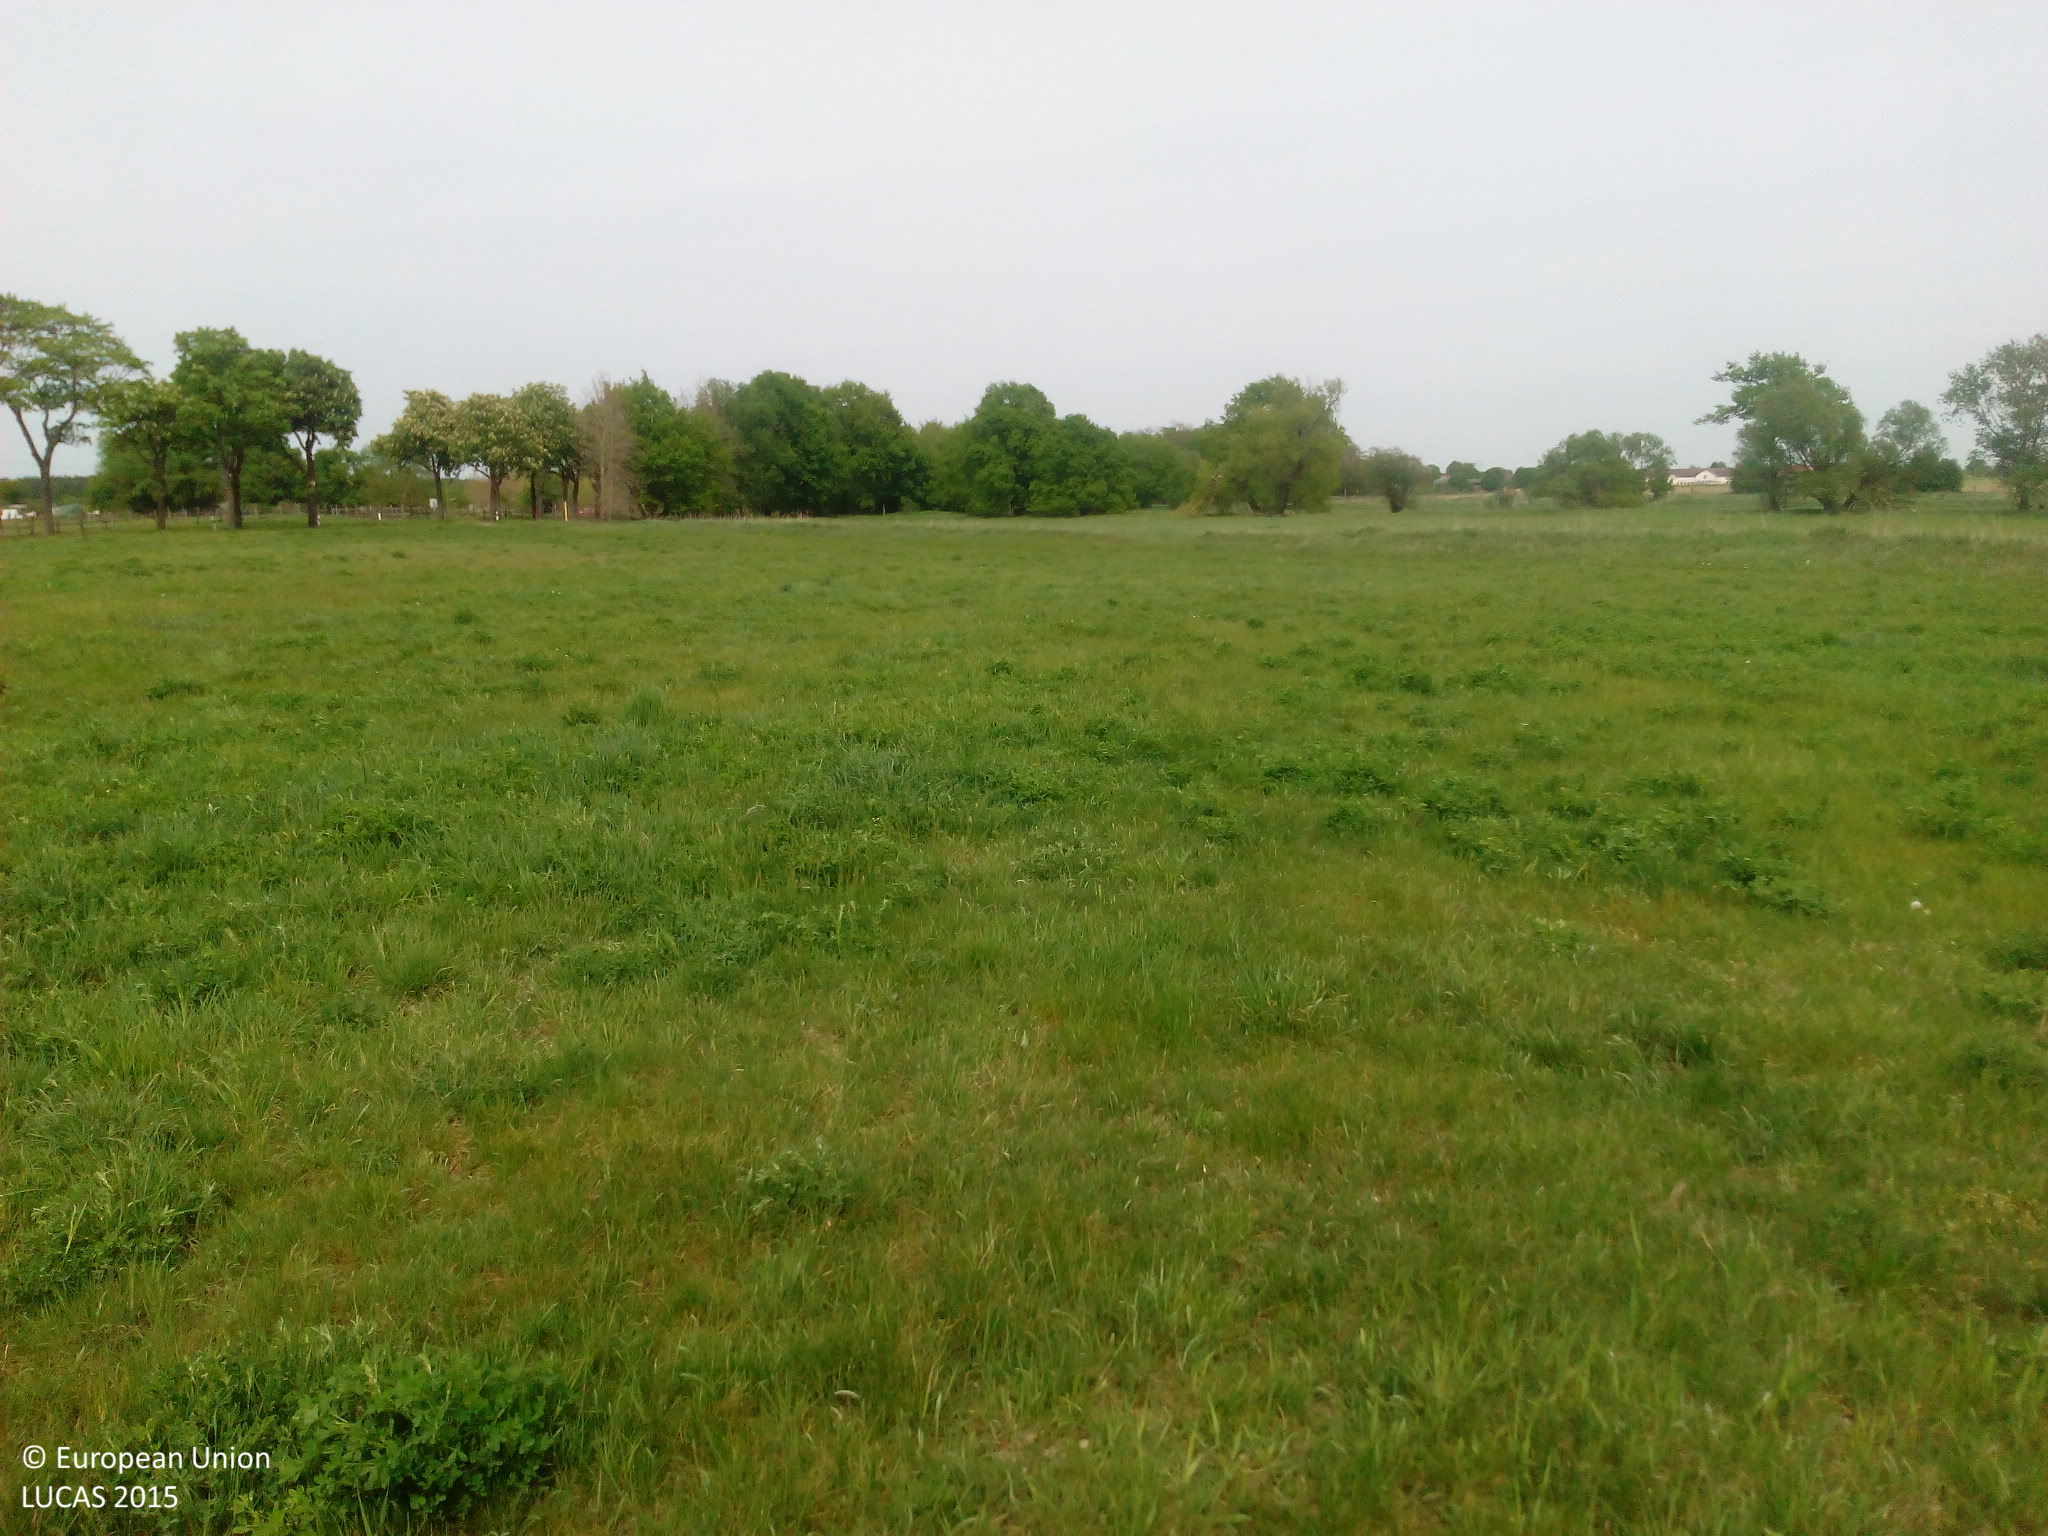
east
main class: Grassland
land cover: Grassland without tree/shrub cover
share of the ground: > 75 %
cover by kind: herbaceous plants 100 %
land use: Agriculture (excluding fallow land and kitchen gardens)
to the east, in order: Grassland without tree/shrub cover; Tracks; Grass margins; Ditches and canals; Temporary grasslands; Inland fresh running water; Grassland without tree/shrub cover; Ditches and canals; Tracks; Fences; Temporary grasslands; Fences; Single bushes/trees
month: May
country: DE
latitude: 52.3348
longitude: 13.1846
